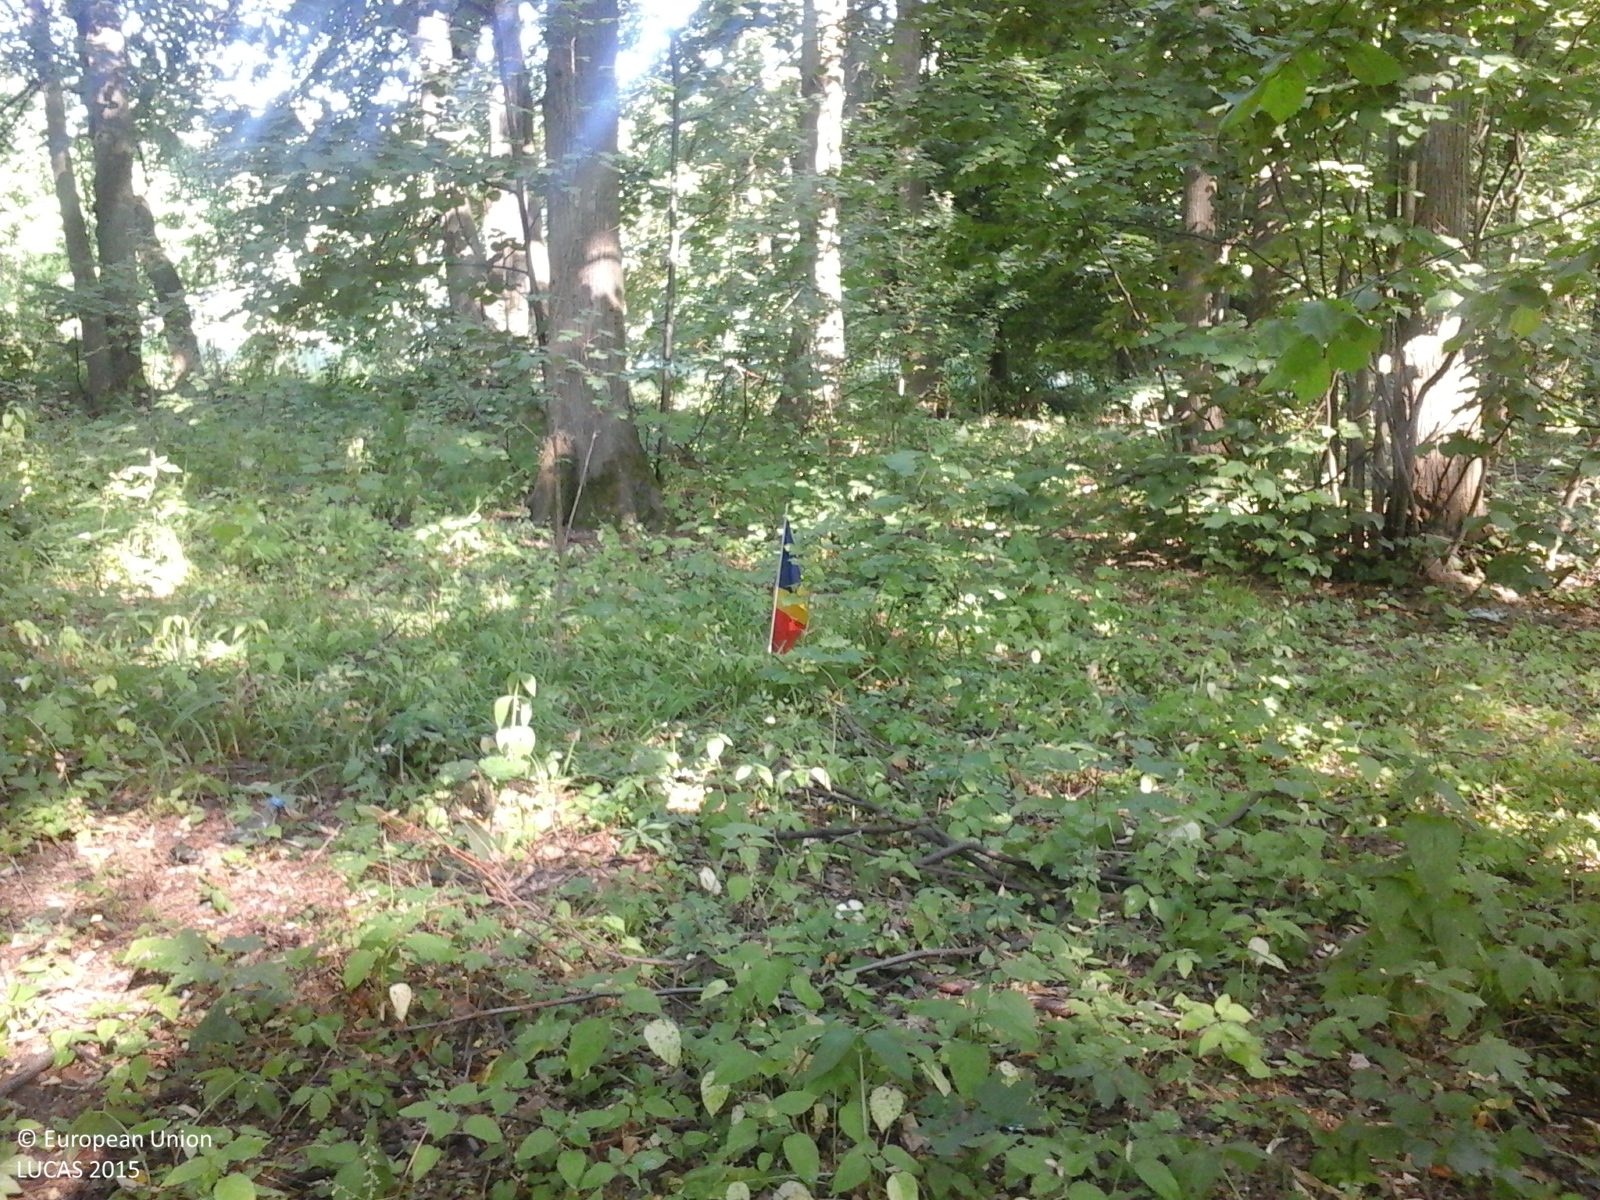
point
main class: Woodland
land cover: Broadleaved woodland
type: mesophytic deciduous forest
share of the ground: > 75 %
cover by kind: broadleaved forest trees 90 %, herbaceous plants 10 %
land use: Forestry
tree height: > 5 m
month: July
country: RO
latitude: 46.0540
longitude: 27.2778
